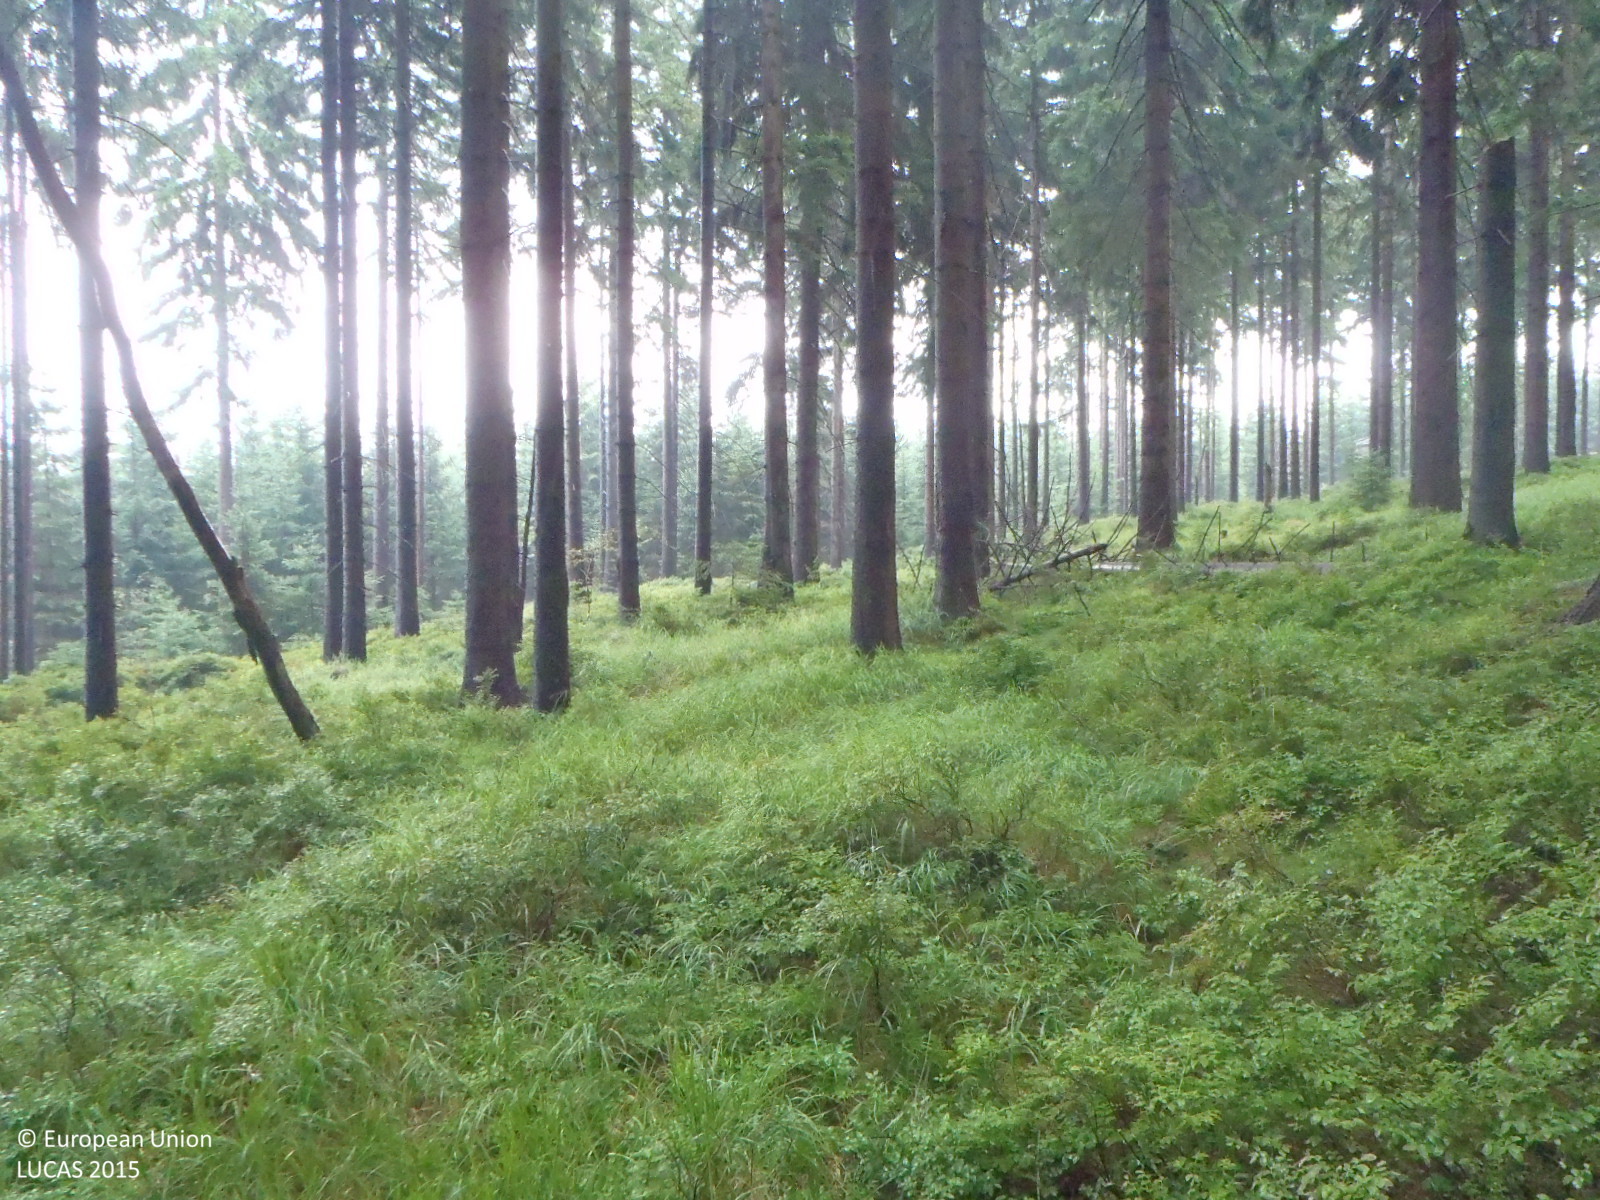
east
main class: Woodland
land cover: Spruce dominated coniferous woodland
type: hemiboreal forest and nemoral coniferous forest and mixed broadleaved-coniferous forest
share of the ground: > 75 %
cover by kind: coniferous forest trees 90 %, broadleaved forest trees 5 %, shrubs 5 %
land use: Forestry
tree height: > 5 m
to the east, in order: Spruce dominated coniferous woodland; Tracks; Spruce dominated coniferous woodland
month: August
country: CZ
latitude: 50.7834
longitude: 15.2657
